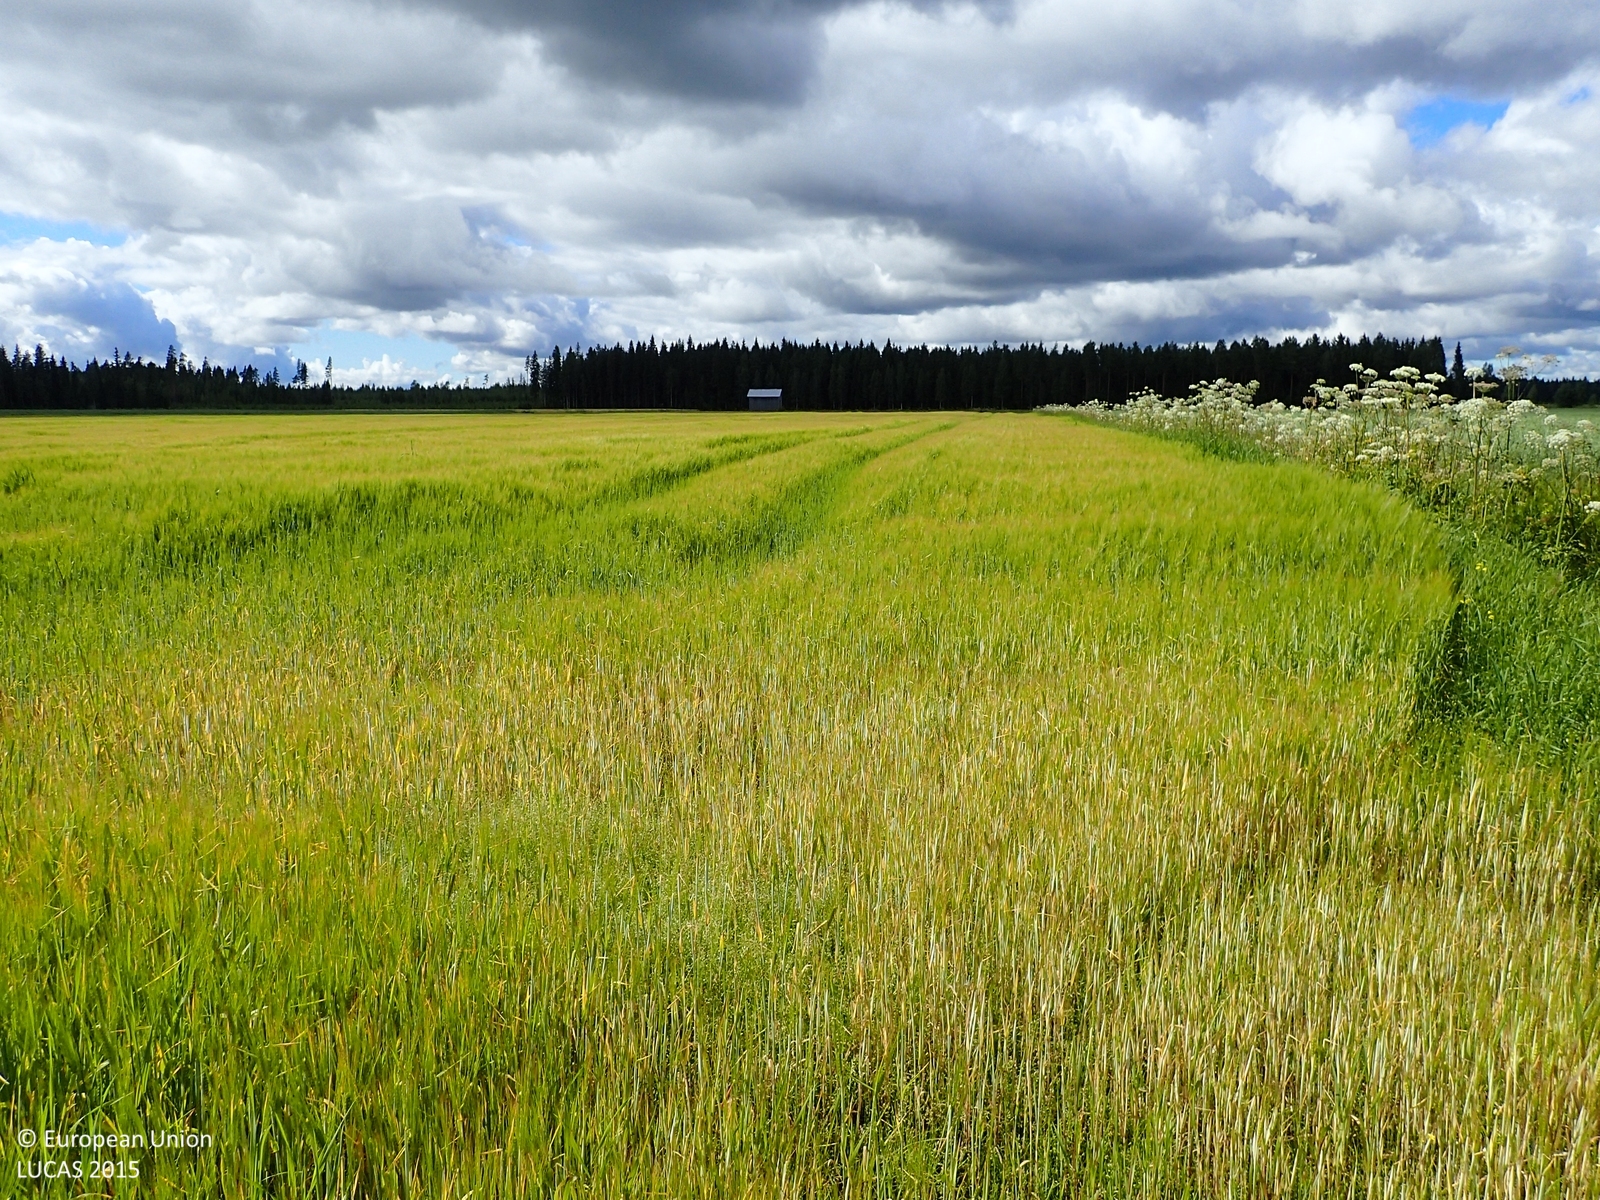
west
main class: Cropland
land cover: Barley
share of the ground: > 75 %
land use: Agriculture (excluding fallow land and kitchen gardens)
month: August
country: FI
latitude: 62.6572
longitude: 21.8134
